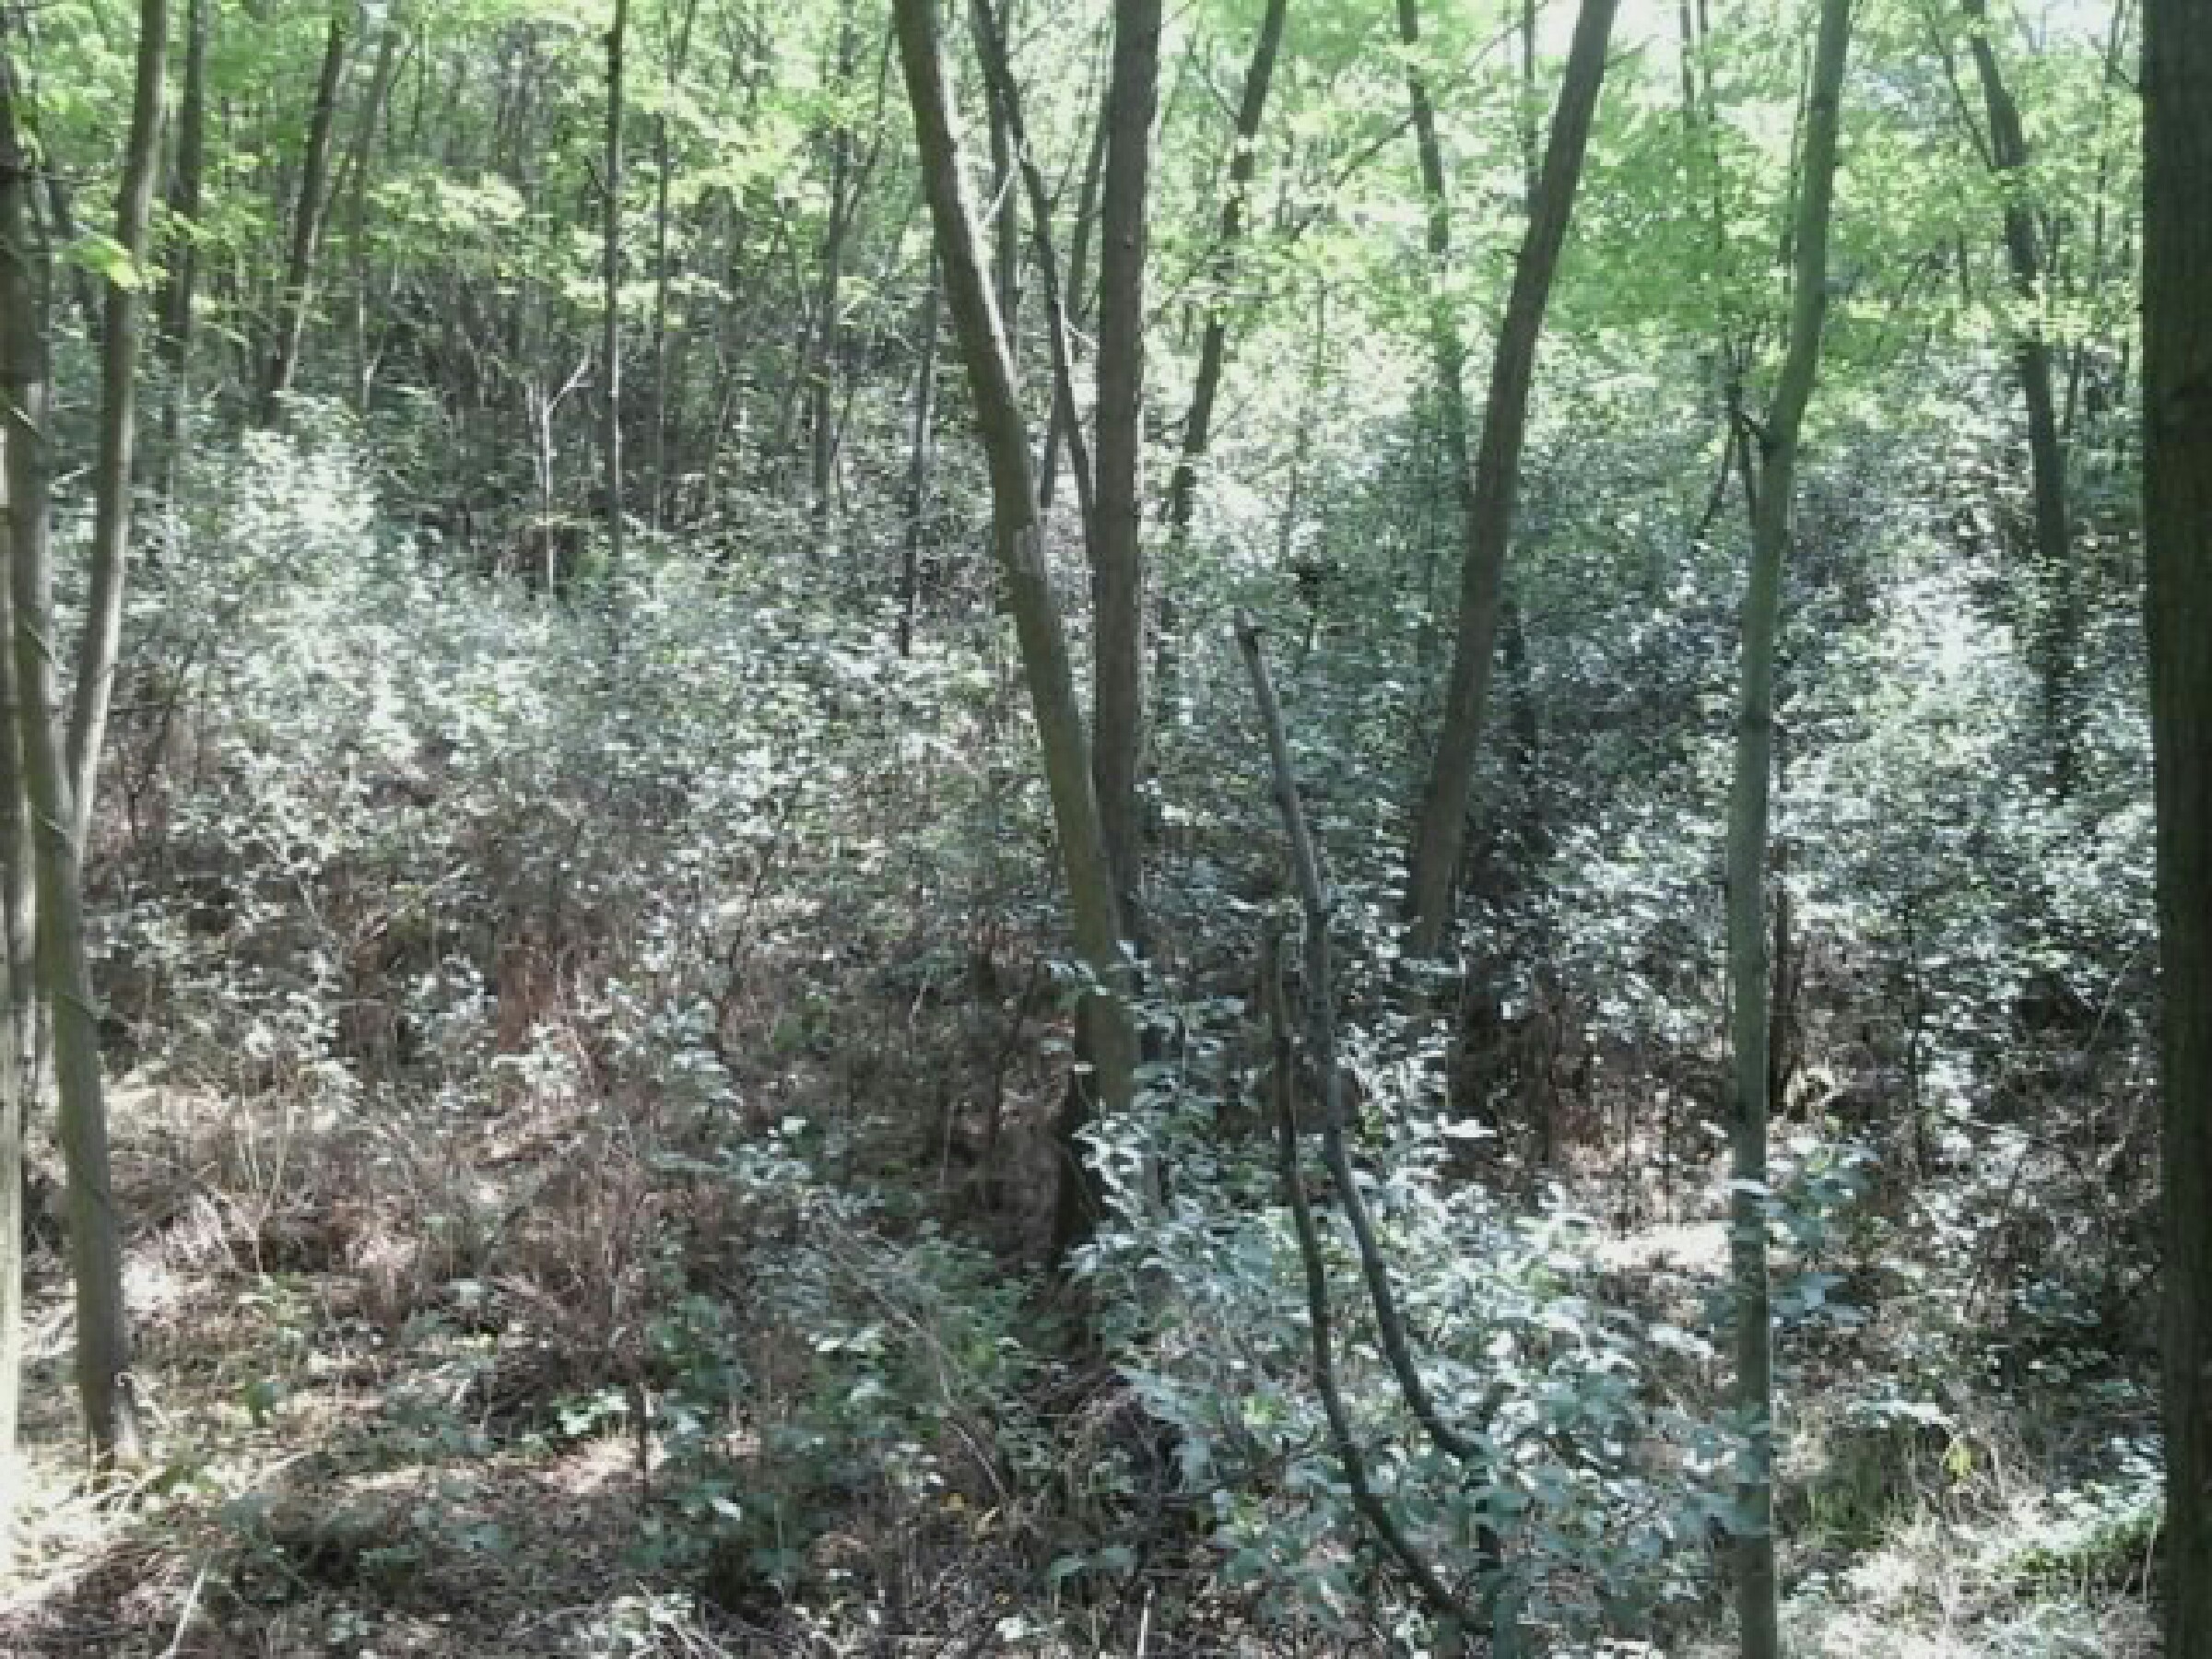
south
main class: Woodland
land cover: Broadleaved woodland
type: exotic forest
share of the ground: > 75 %
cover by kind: broadleaved forest trees 100 %
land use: Forestry
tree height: > 5 m
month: August
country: HU
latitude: 47.9317
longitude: 19.3781
